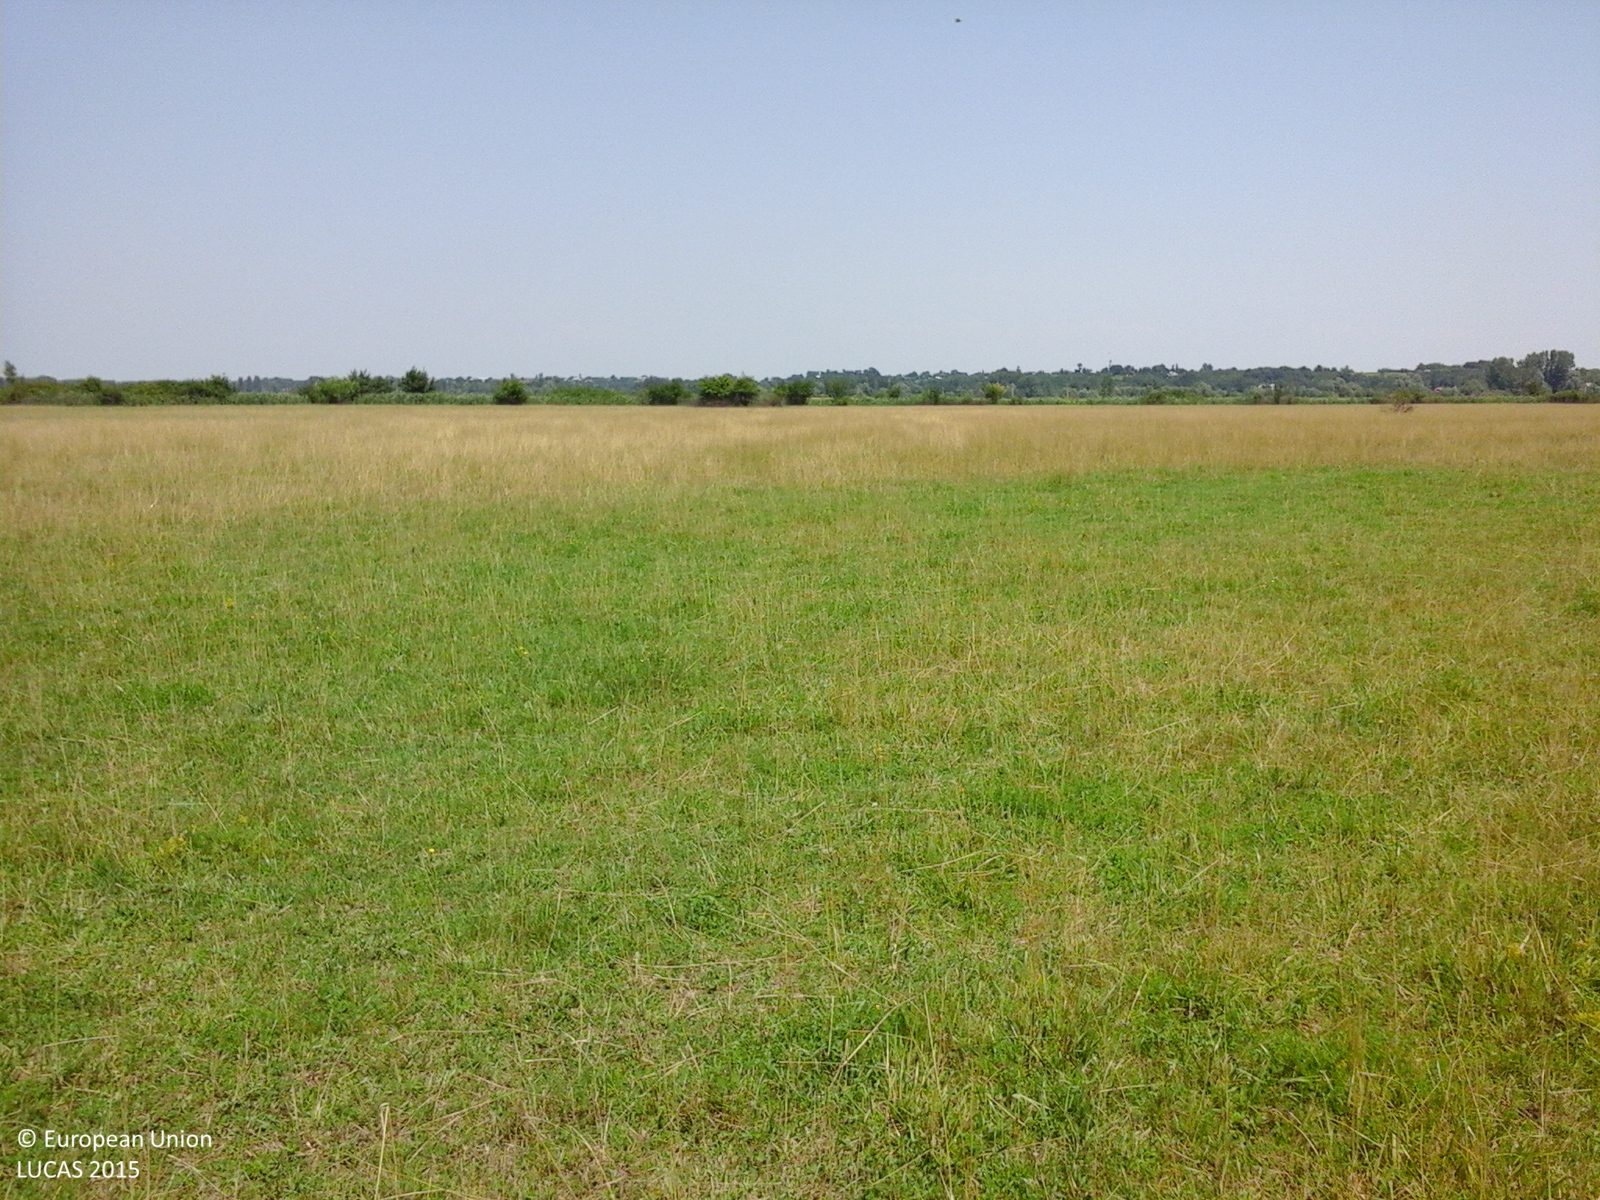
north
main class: Grassland
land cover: Grassland without tree/shrub cover
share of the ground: > 75 %
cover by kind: herbaceous plants 100 %
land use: Agriculture (excluding fallow land and kitchen gardens)
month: July
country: RO
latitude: 44.5609
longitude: 24.9494
